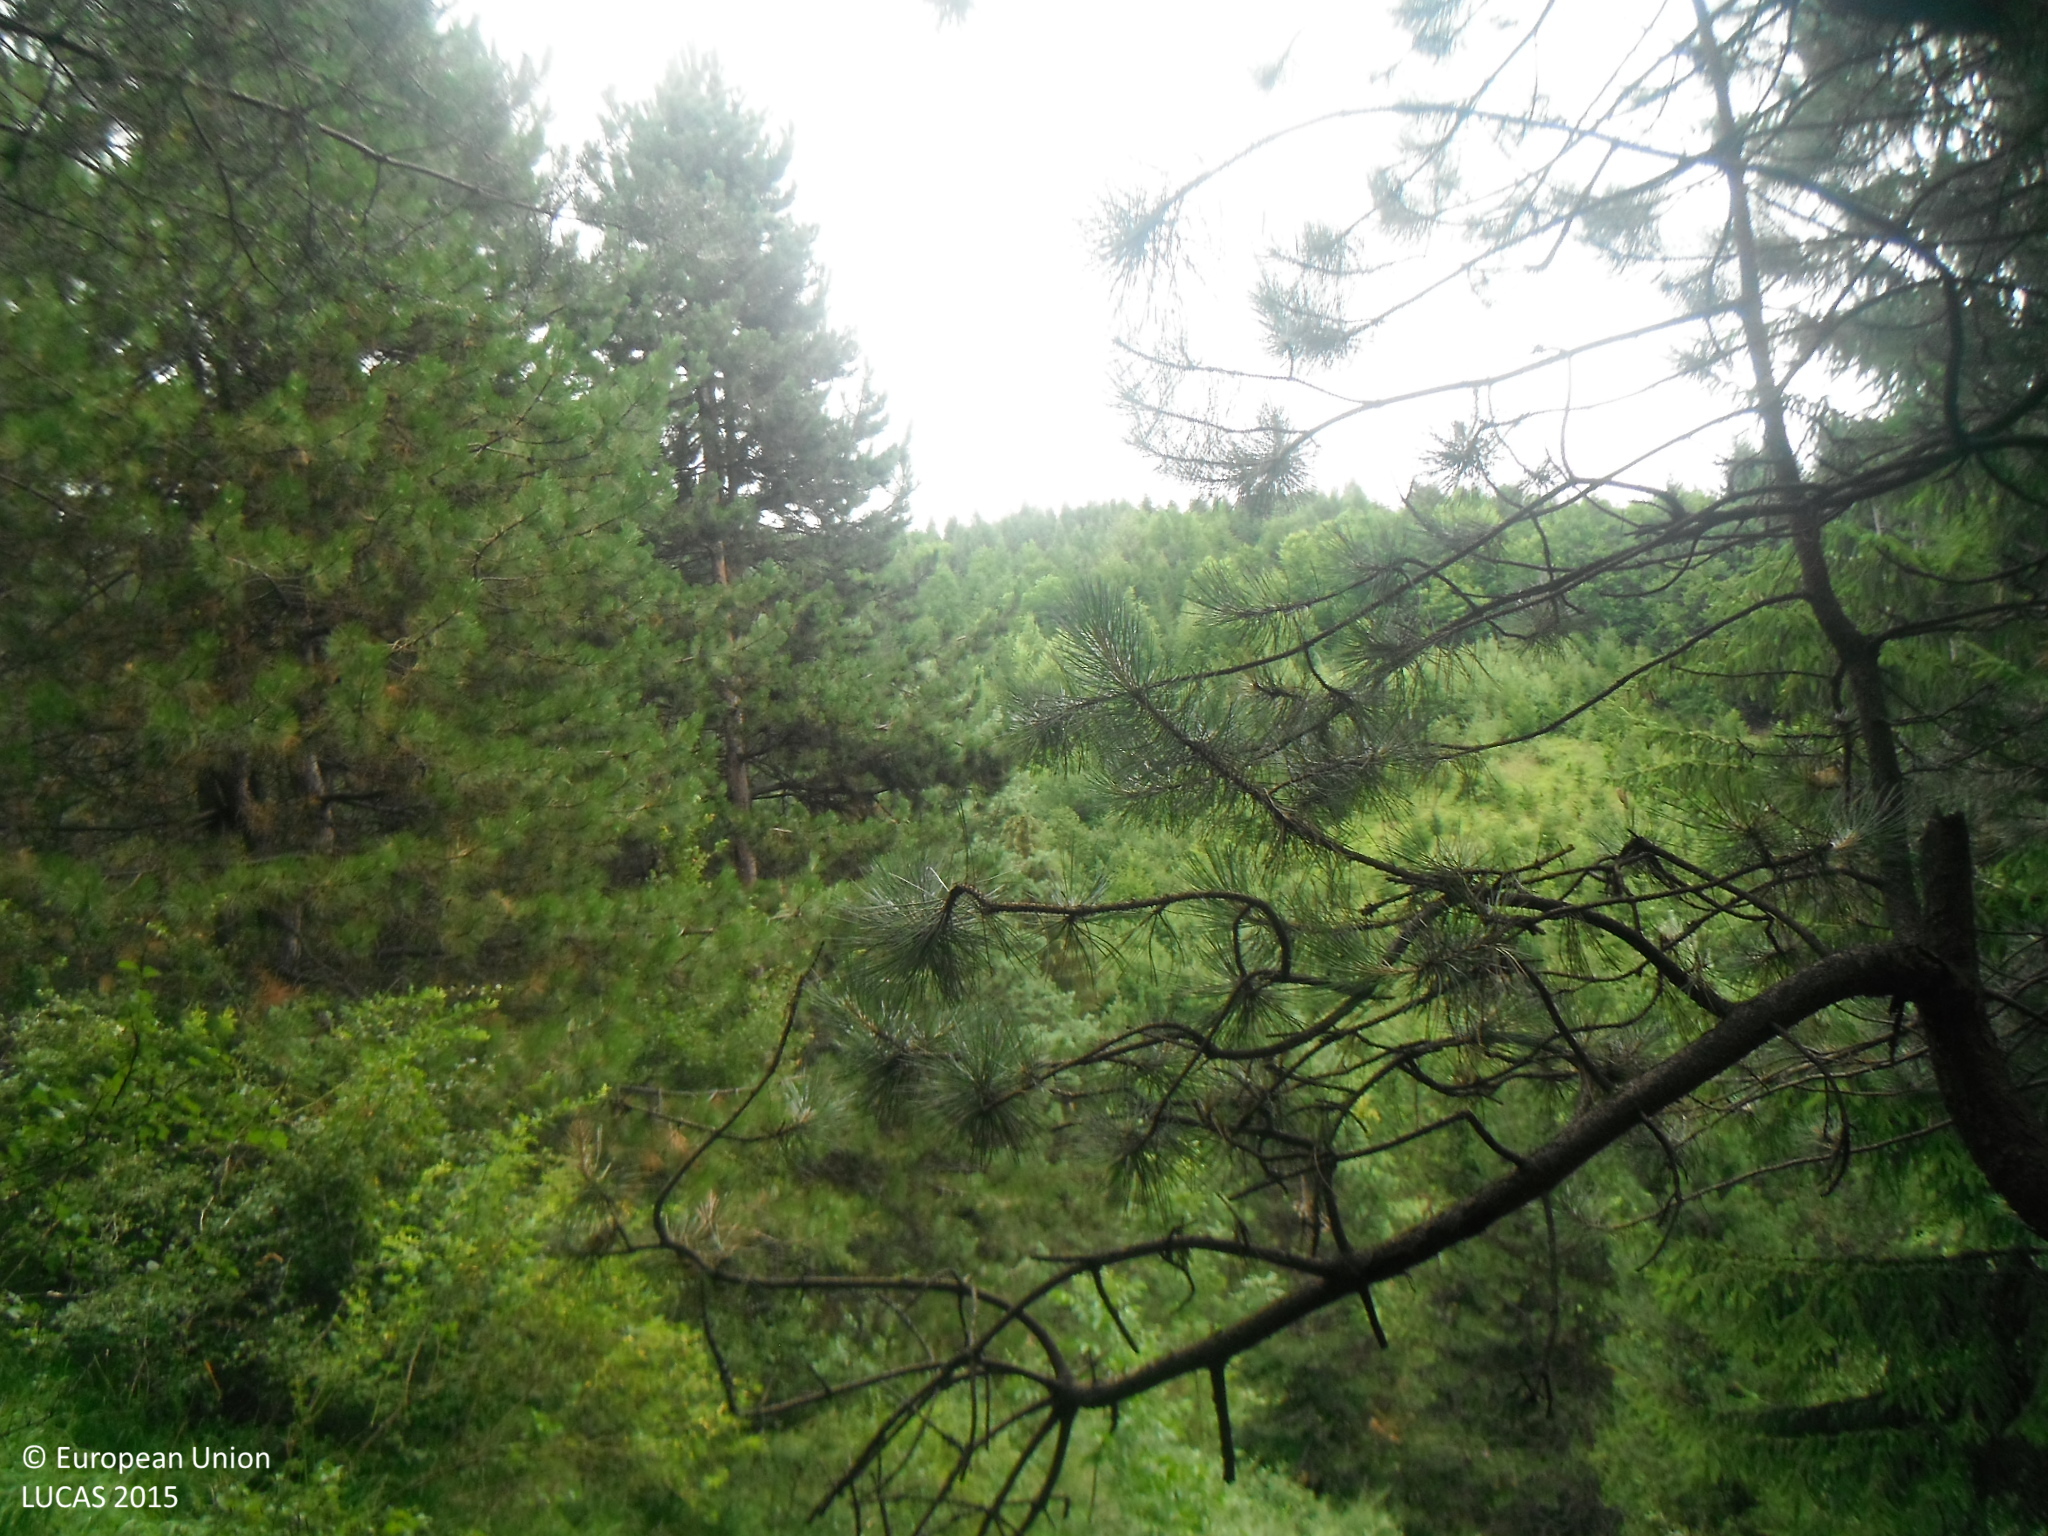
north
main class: Woodland
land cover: Pine dominated coniferous woodland
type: alpine coniferous forest
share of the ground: > 75 %
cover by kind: coniferous forest trees 75 %, herbaceous plants 15 %, shrubs 10 %
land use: Forestry
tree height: > 5 m
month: July
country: SK
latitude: 49.2403
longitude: 18.4097
